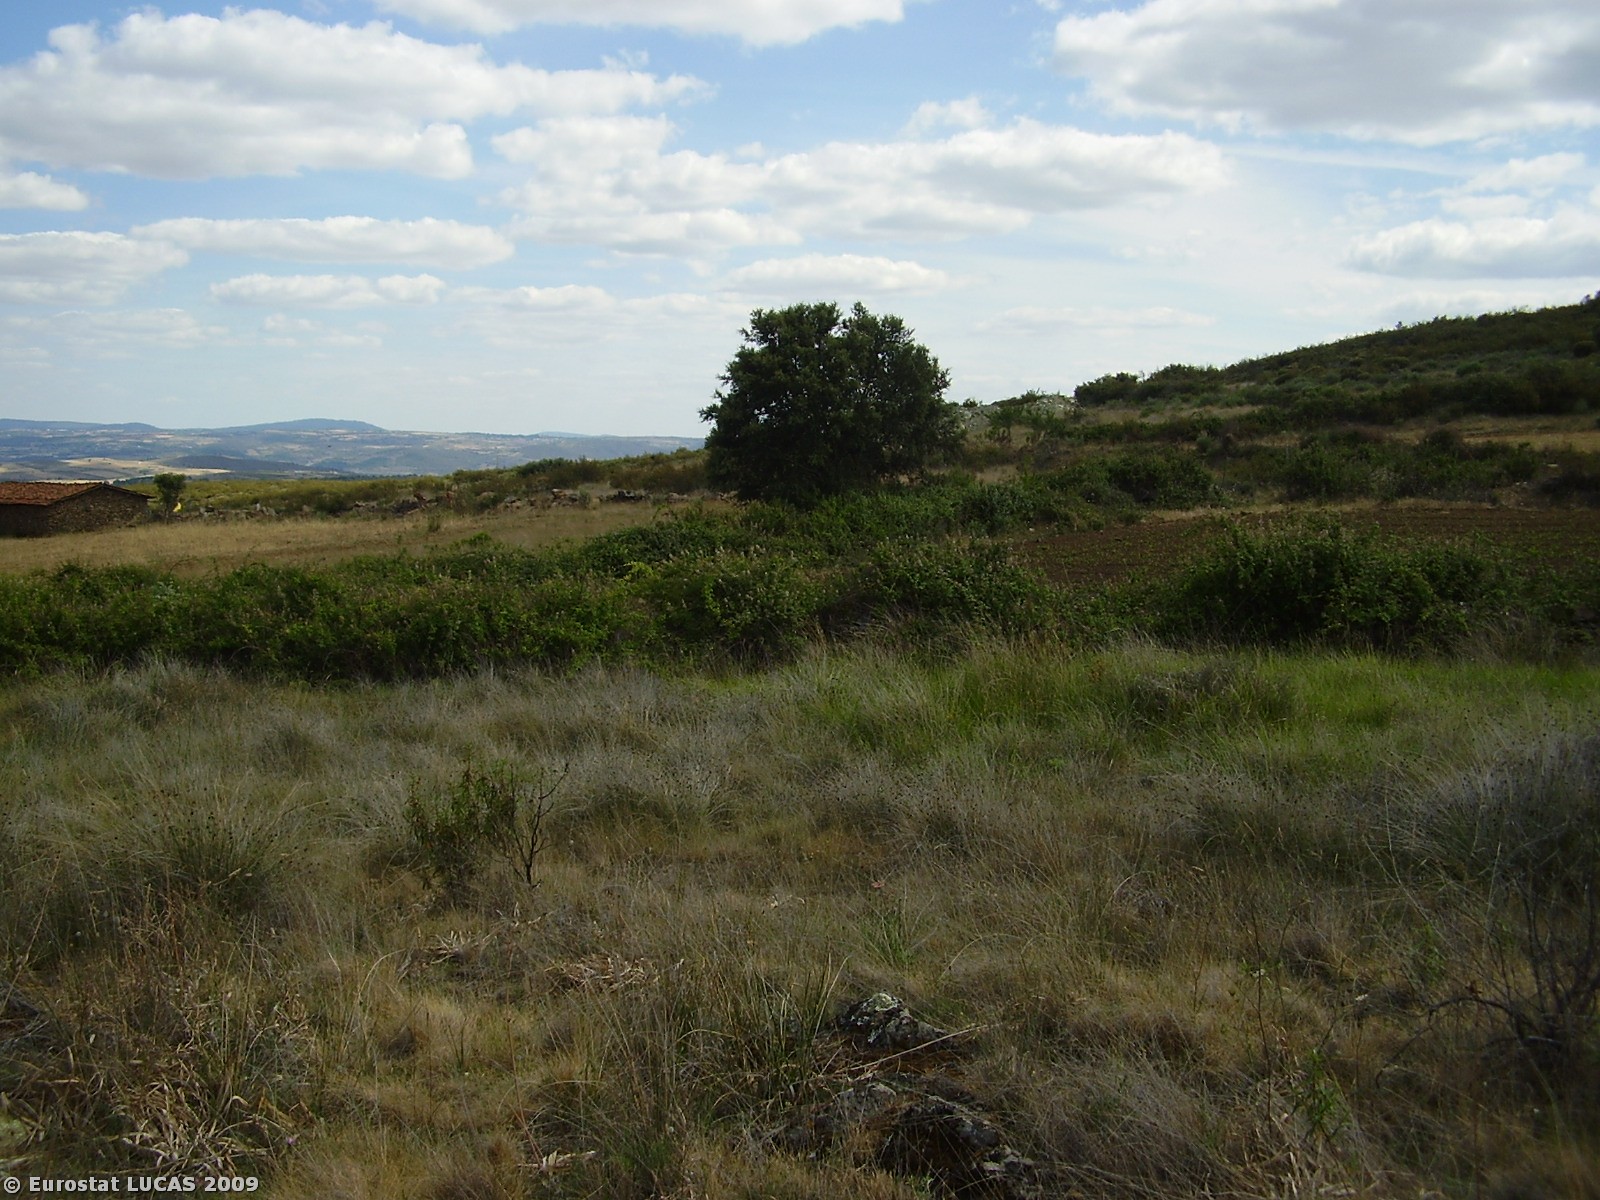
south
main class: Grassland
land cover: Spontaneously vegetated surfaces
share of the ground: > 75 %
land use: Fallow land
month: June
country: PT
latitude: 41.5013
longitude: -6.7729
